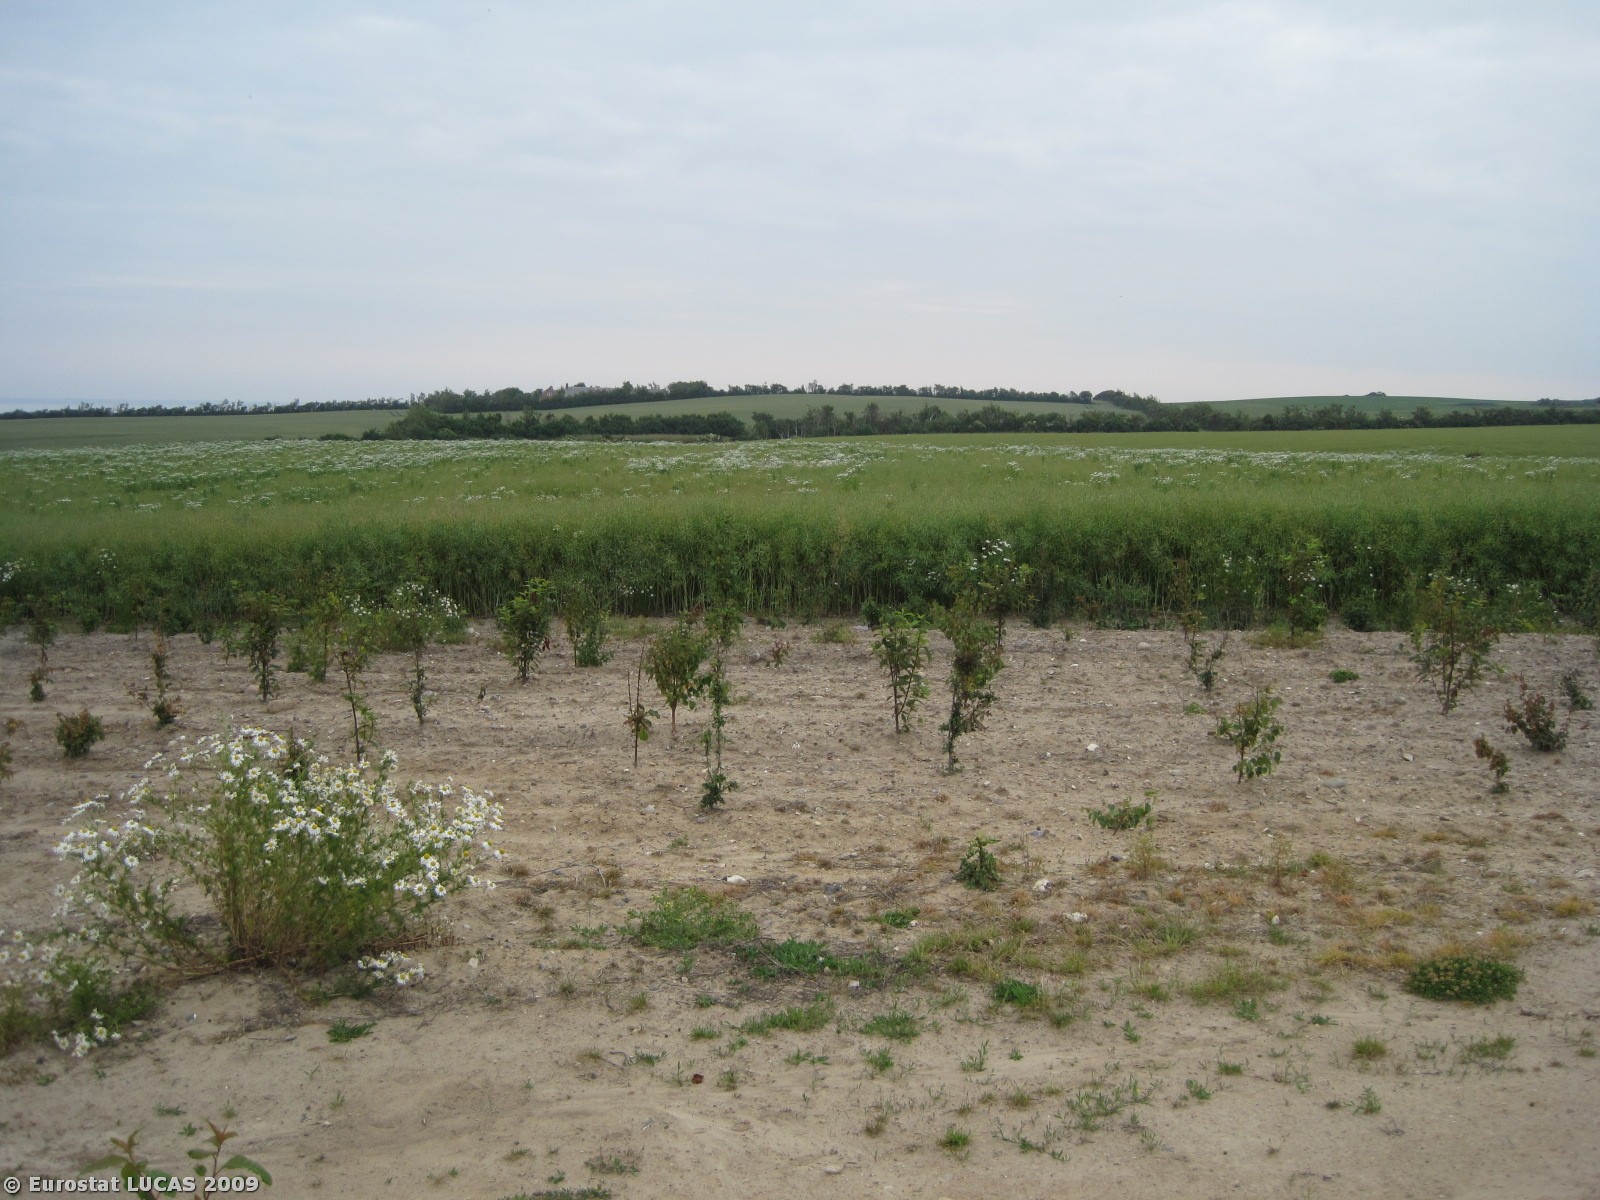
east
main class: Grassland
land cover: Grassland with sparse tree/shrub cover
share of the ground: 10 - 25 %
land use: Agriculture (excluding fallow land and kitchen gardens)
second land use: Amenities, museums, leisure
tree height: < 5 m
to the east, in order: Grassland with sparse tree/shrub cover; Common wheat; Rape and turnip rape; Grassland with sparse tree/shrub cover; Grassland without tree/shrub cover; Ditches and canals; Grassland without tree/shrub cover; Rape and turnip rape
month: June
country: DK
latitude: 56.5724
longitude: 8.3256
